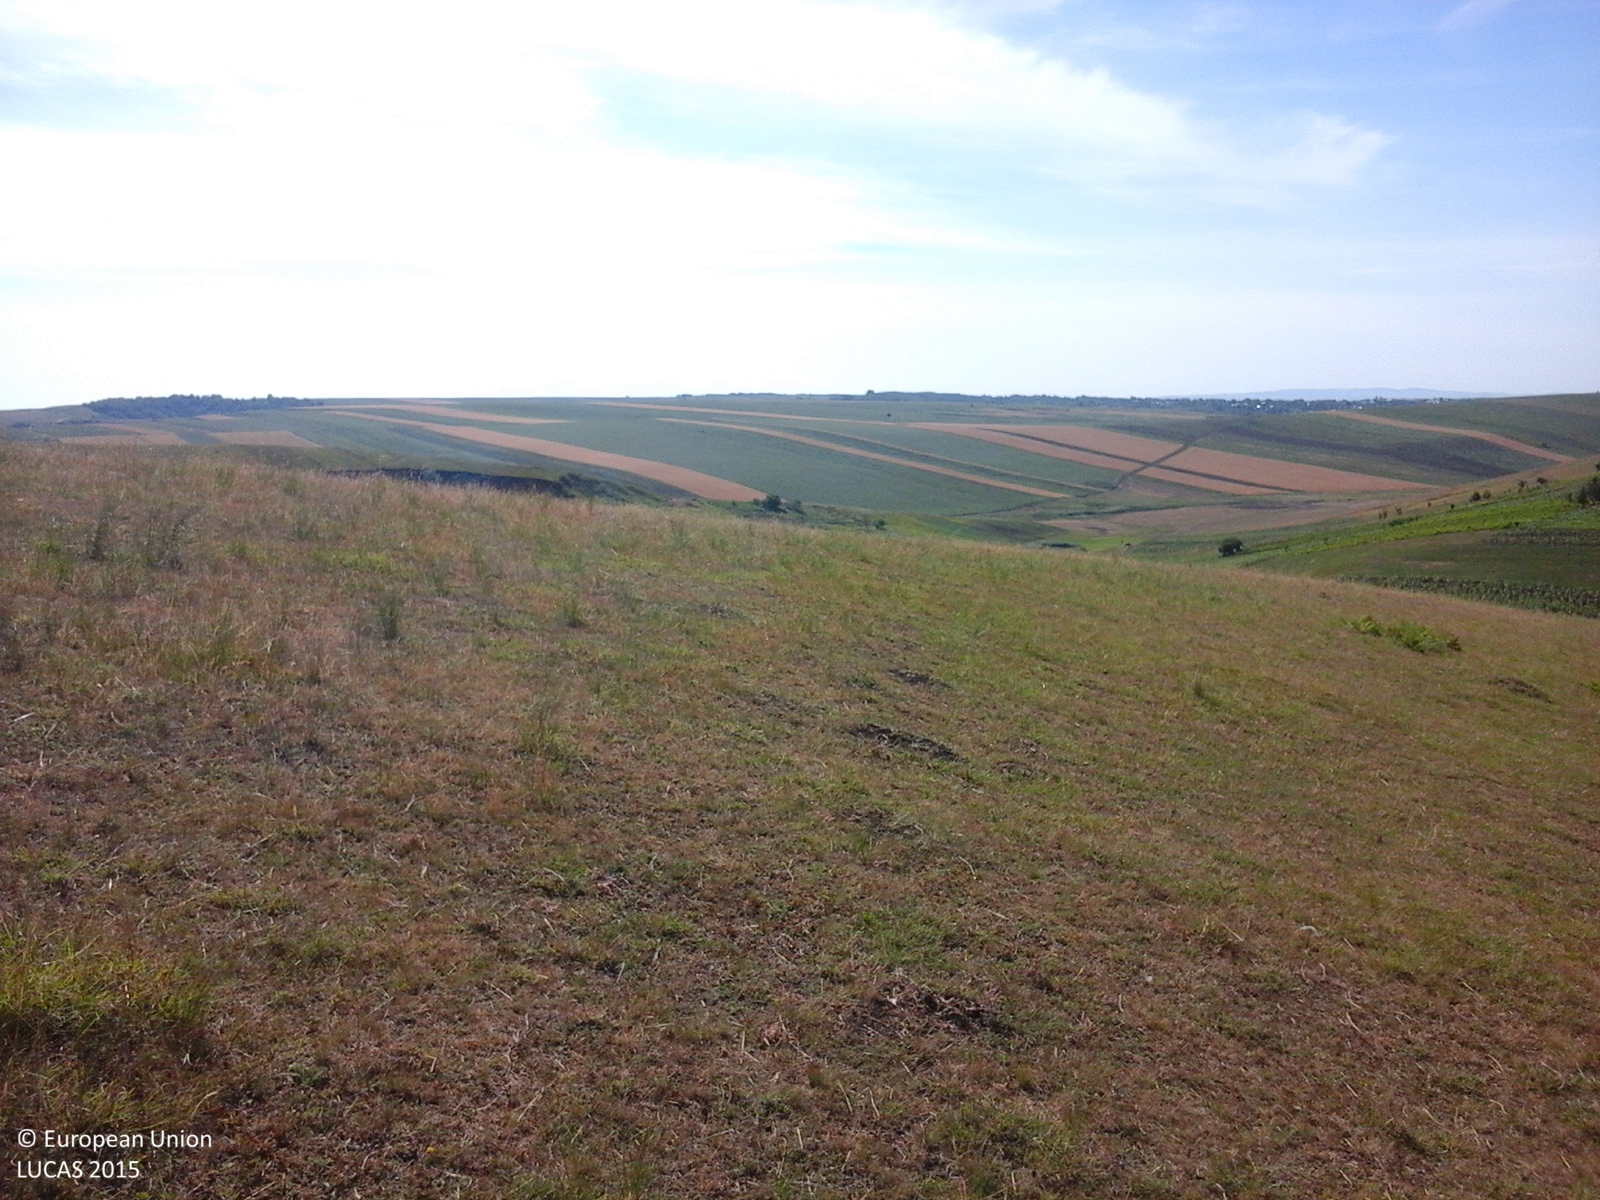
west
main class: Grassland
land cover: Grassland without tree/shrub cover
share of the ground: > 75 %
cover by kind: herbaceous plants 100 %
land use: Agriculture (excluding fallow land and kitchen gardens)
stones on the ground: < 10 %
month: June
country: RO
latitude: 47.3290
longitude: 27.2452
